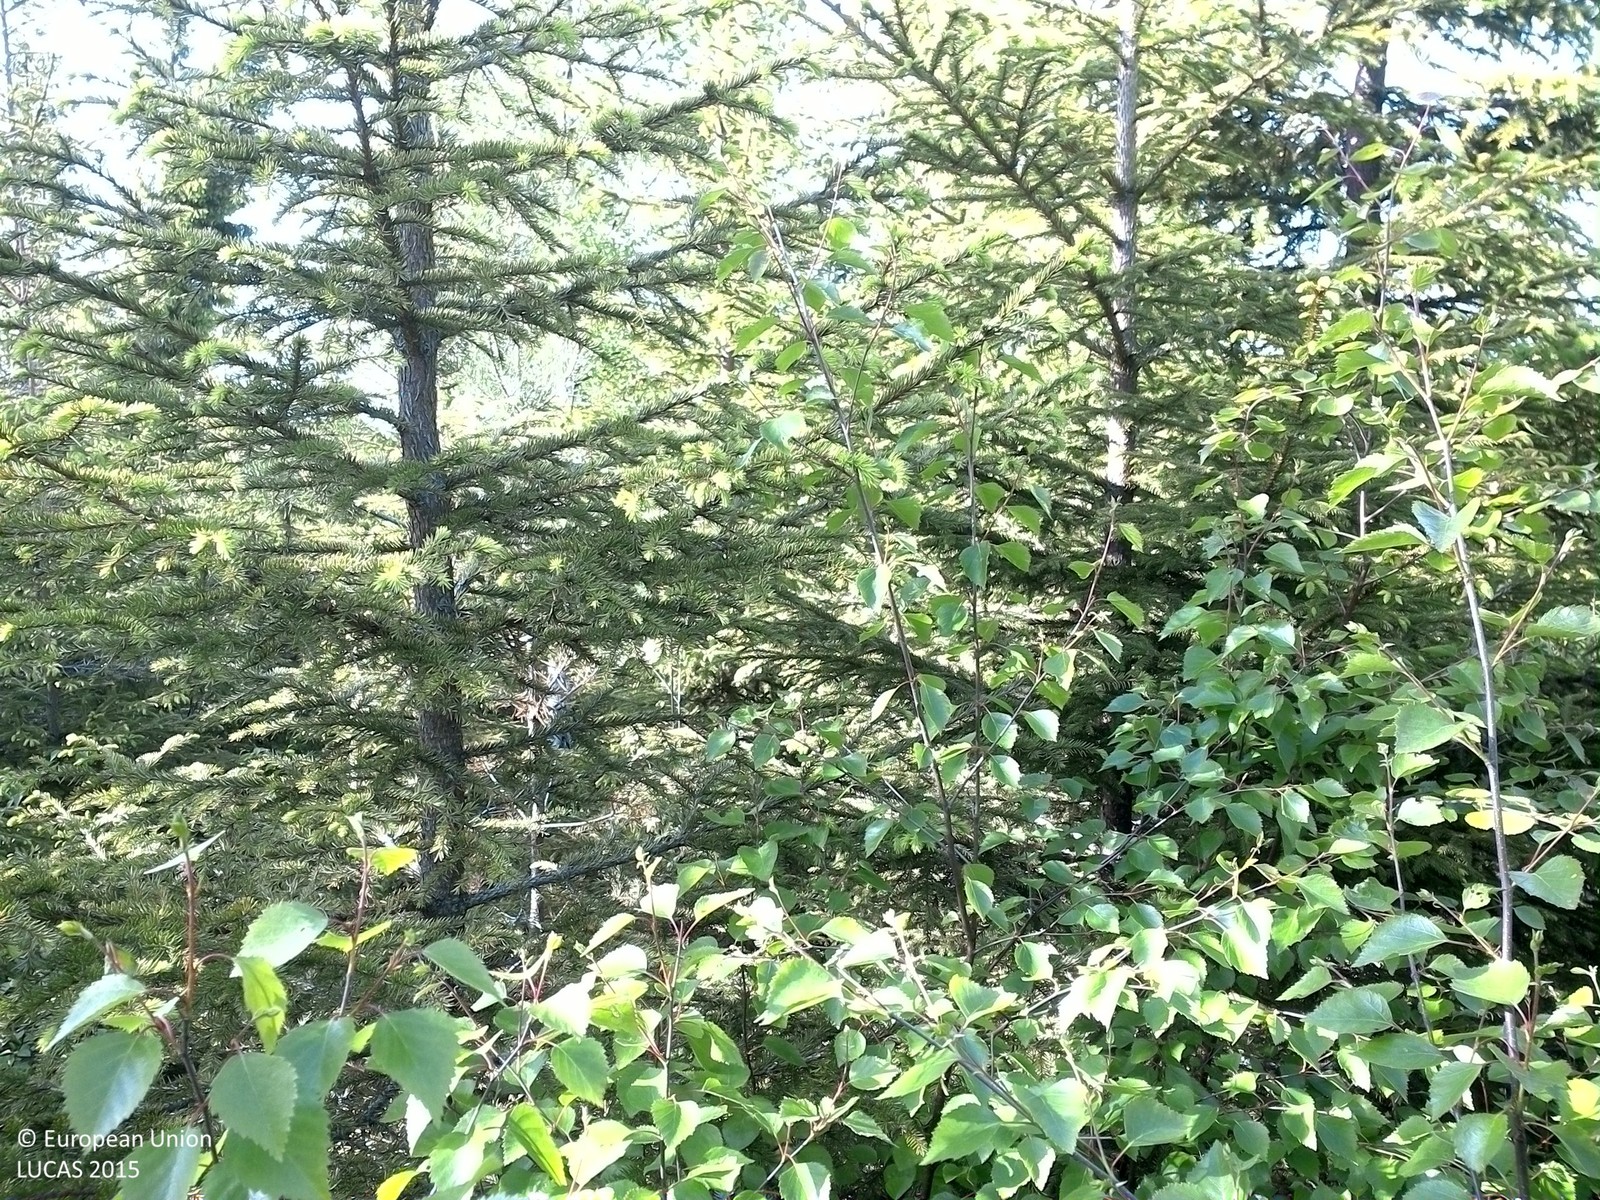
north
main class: Woodland
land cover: Spruce dominated mixed woodland
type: boreal forest
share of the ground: > 75 %
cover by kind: coniferous forest trees 60 %, broadleaved forest trees 20 %, shrubs 10 %, herbaceous plants 10 %
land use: Forestry
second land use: Amenities, museums, leisure
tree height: < 5 m
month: June
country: SE
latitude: 62.6337
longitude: 17.6822
